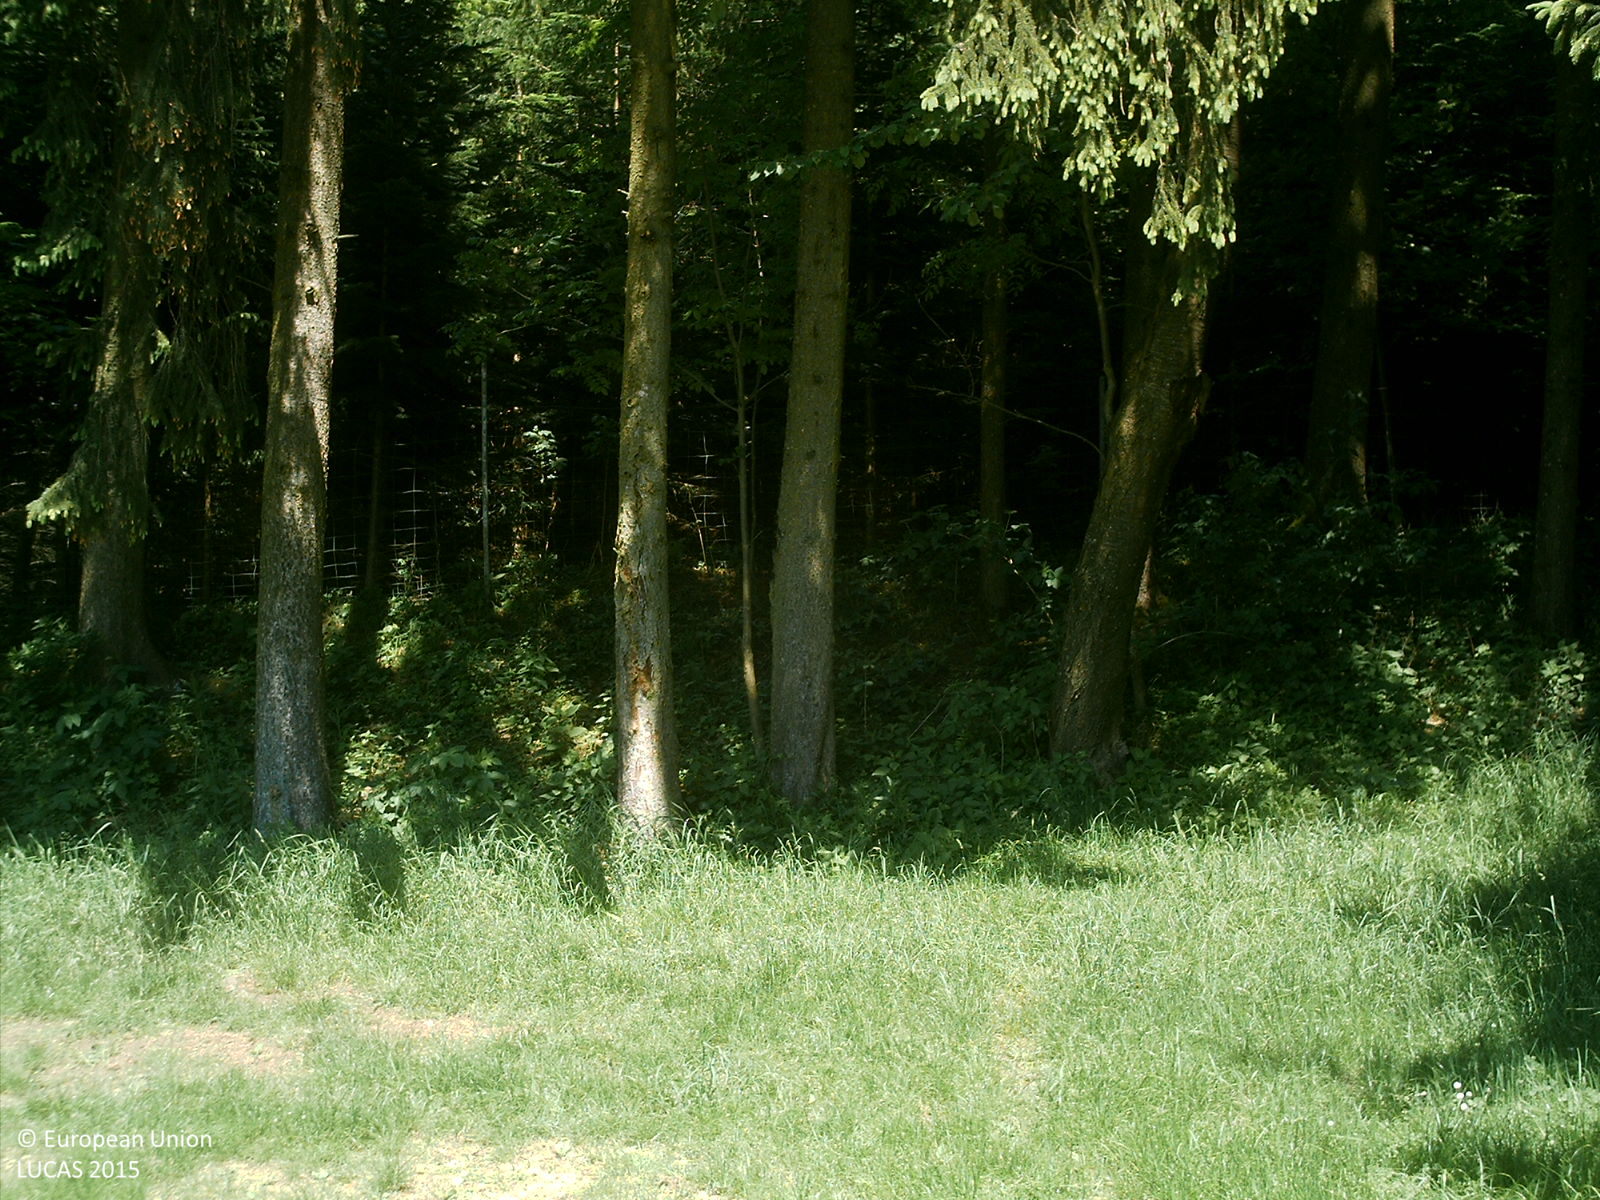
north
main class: Cropland
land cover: Maize
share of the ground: < 10 %
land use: Agriculture (excluding fallow land and kitchen gardens)
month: May
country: AT
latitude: 48.0246
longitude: 14.0087
